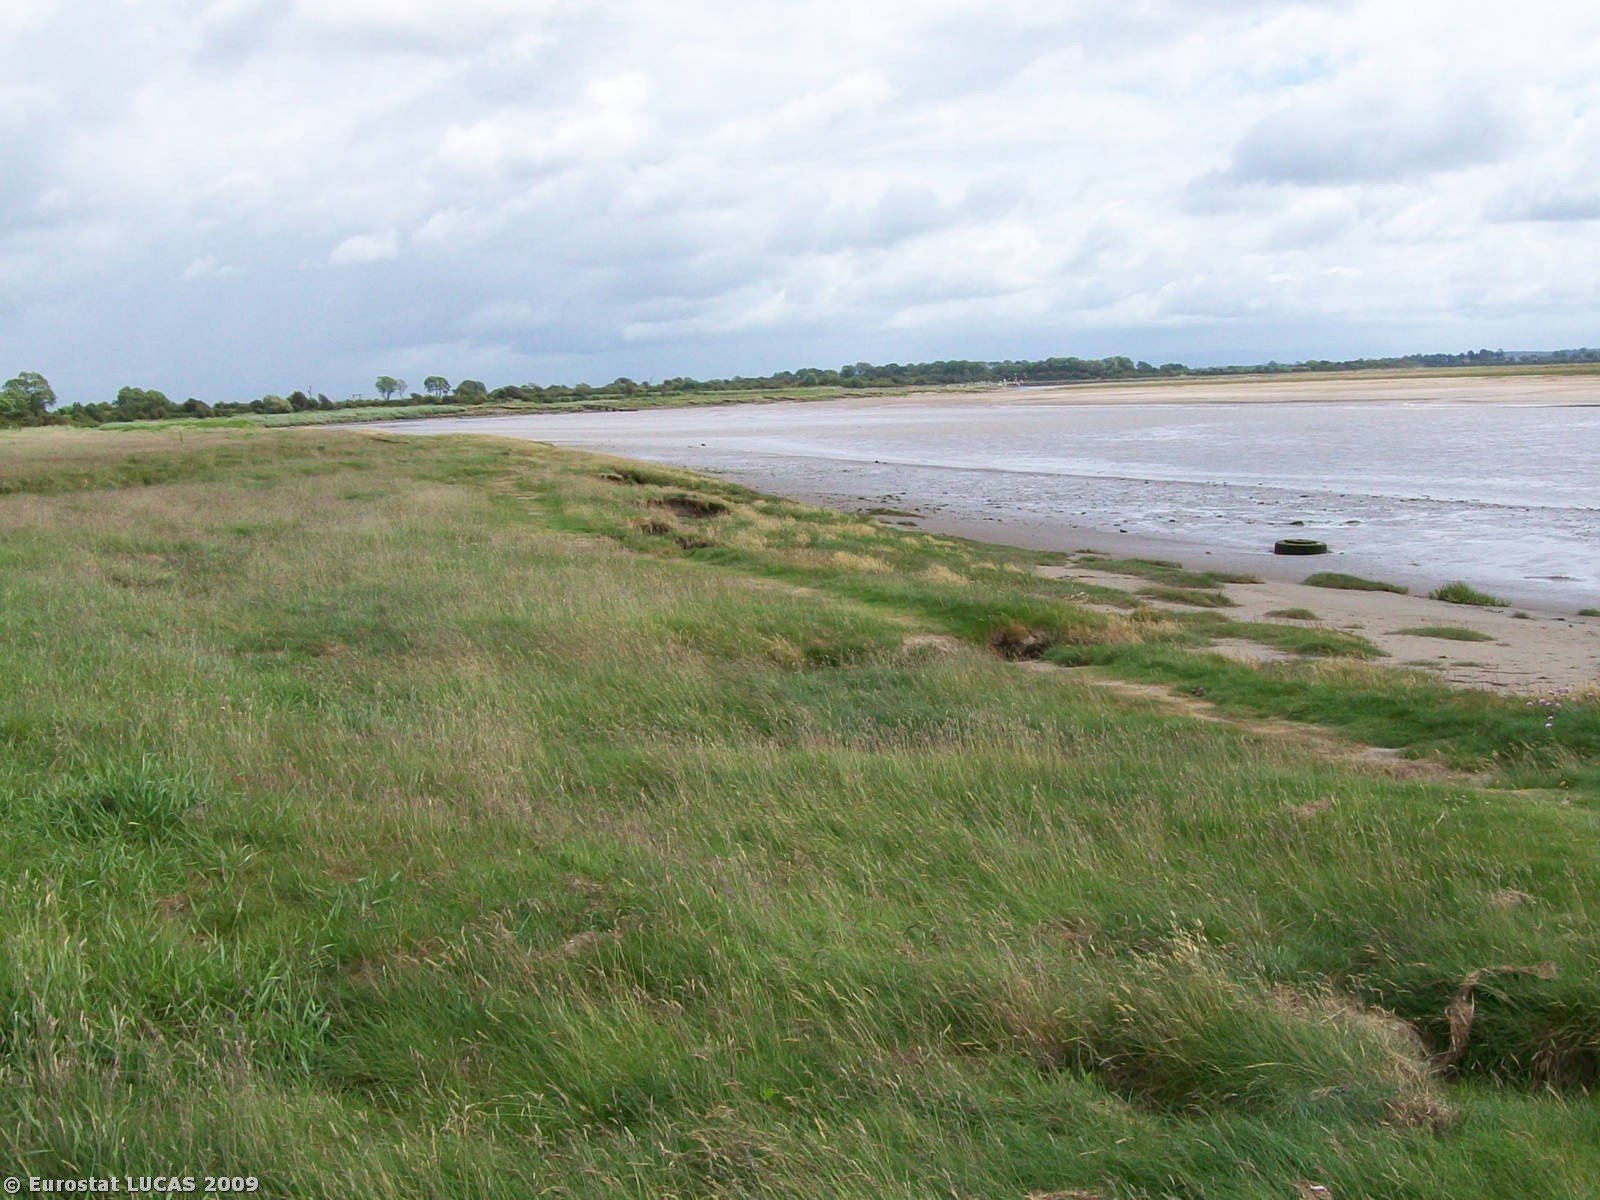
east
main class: Wetlands
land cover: Salt marshes
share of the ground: > 75 %
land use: Unused
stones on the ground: < 10 %
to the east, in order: Salt marshes; Intertidal flats; Transitional water bodies; Intertidal flats
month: June
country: GB
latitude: 54.9120
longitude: -3.2572
